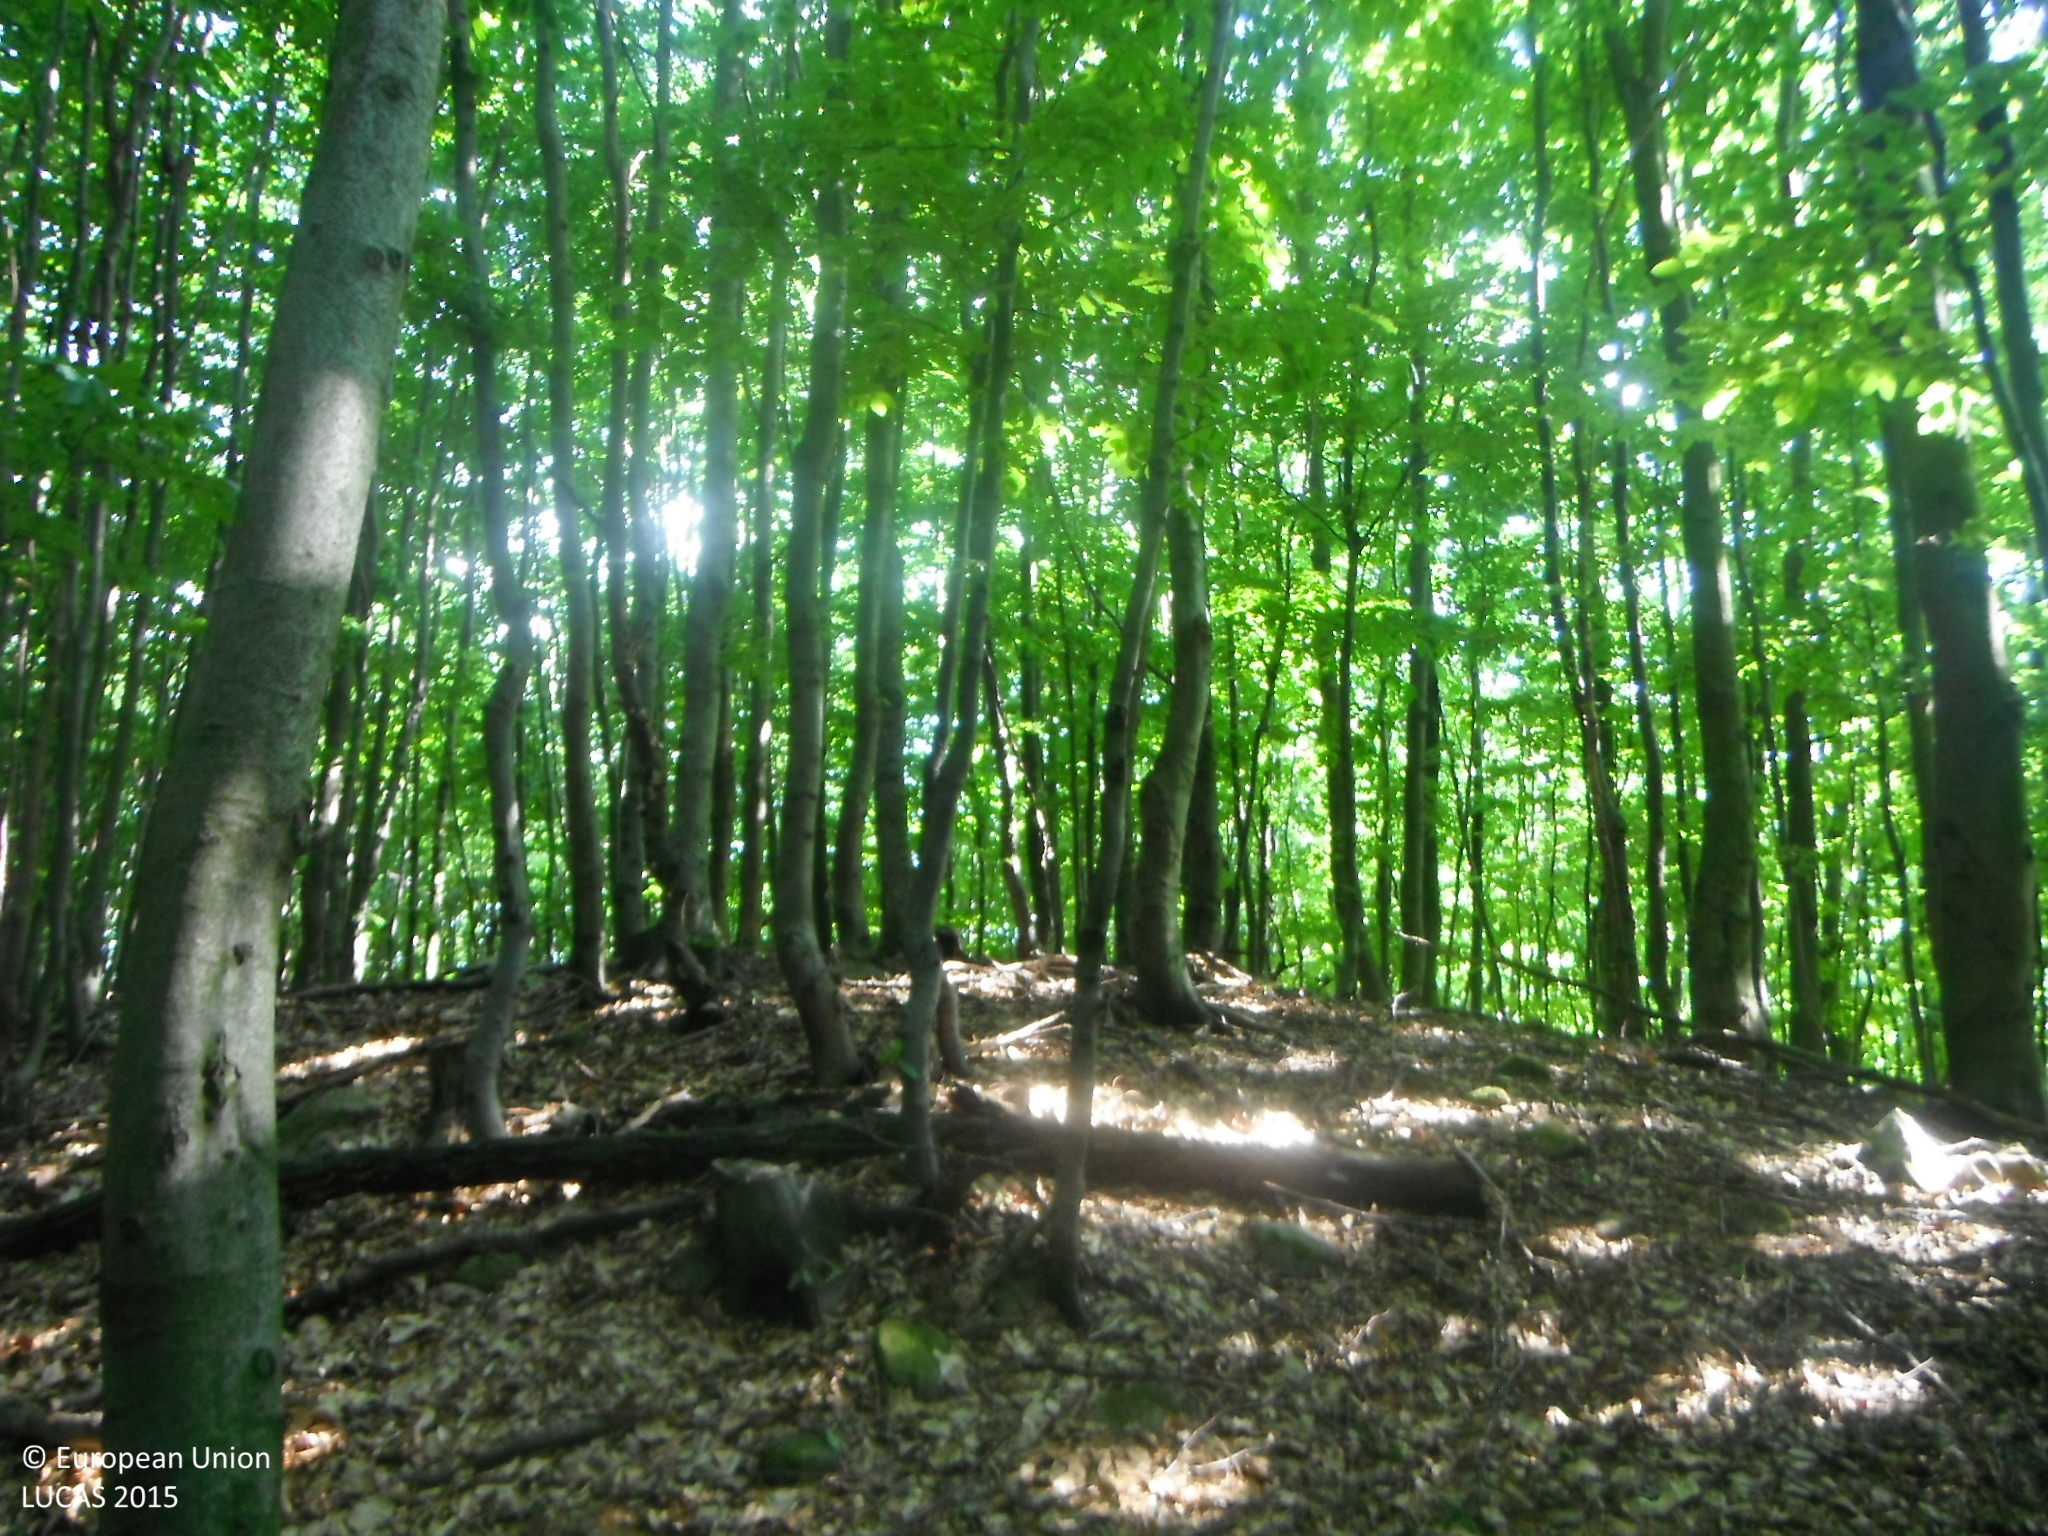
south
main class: Woodland
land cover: Broadleaved woodland
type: beech forest
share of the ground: > 75 %
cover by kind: broadleaved forest trees 100 %
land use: Forestry
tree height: > 5 m
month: June
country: SK
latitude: 48.4173
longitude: 17.2650
